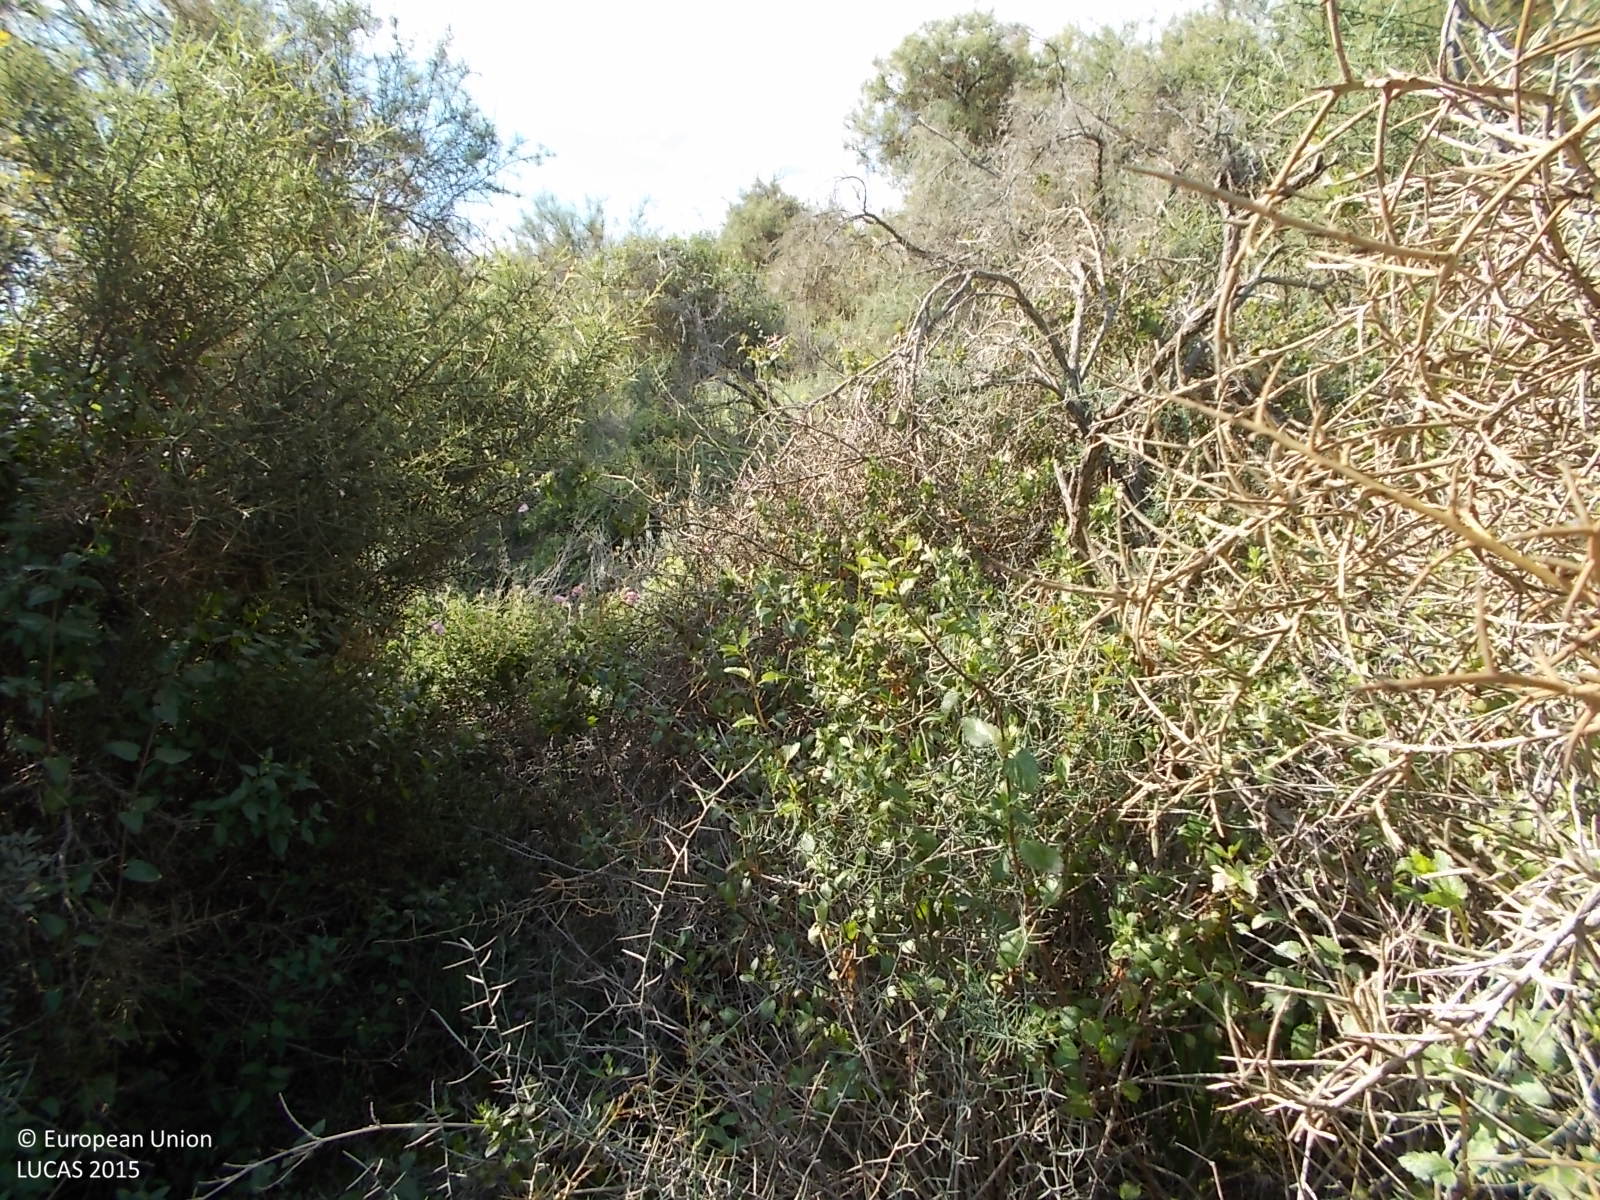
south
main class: Shrubland
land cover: Shrubland without tree cover
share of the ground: > 75 %
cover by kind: shrubs 90 %, herbaceous plants 10 %
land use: Semi-natural and natural areas not in use
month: April
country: CY
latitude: 34.8761
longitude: 33.4808
